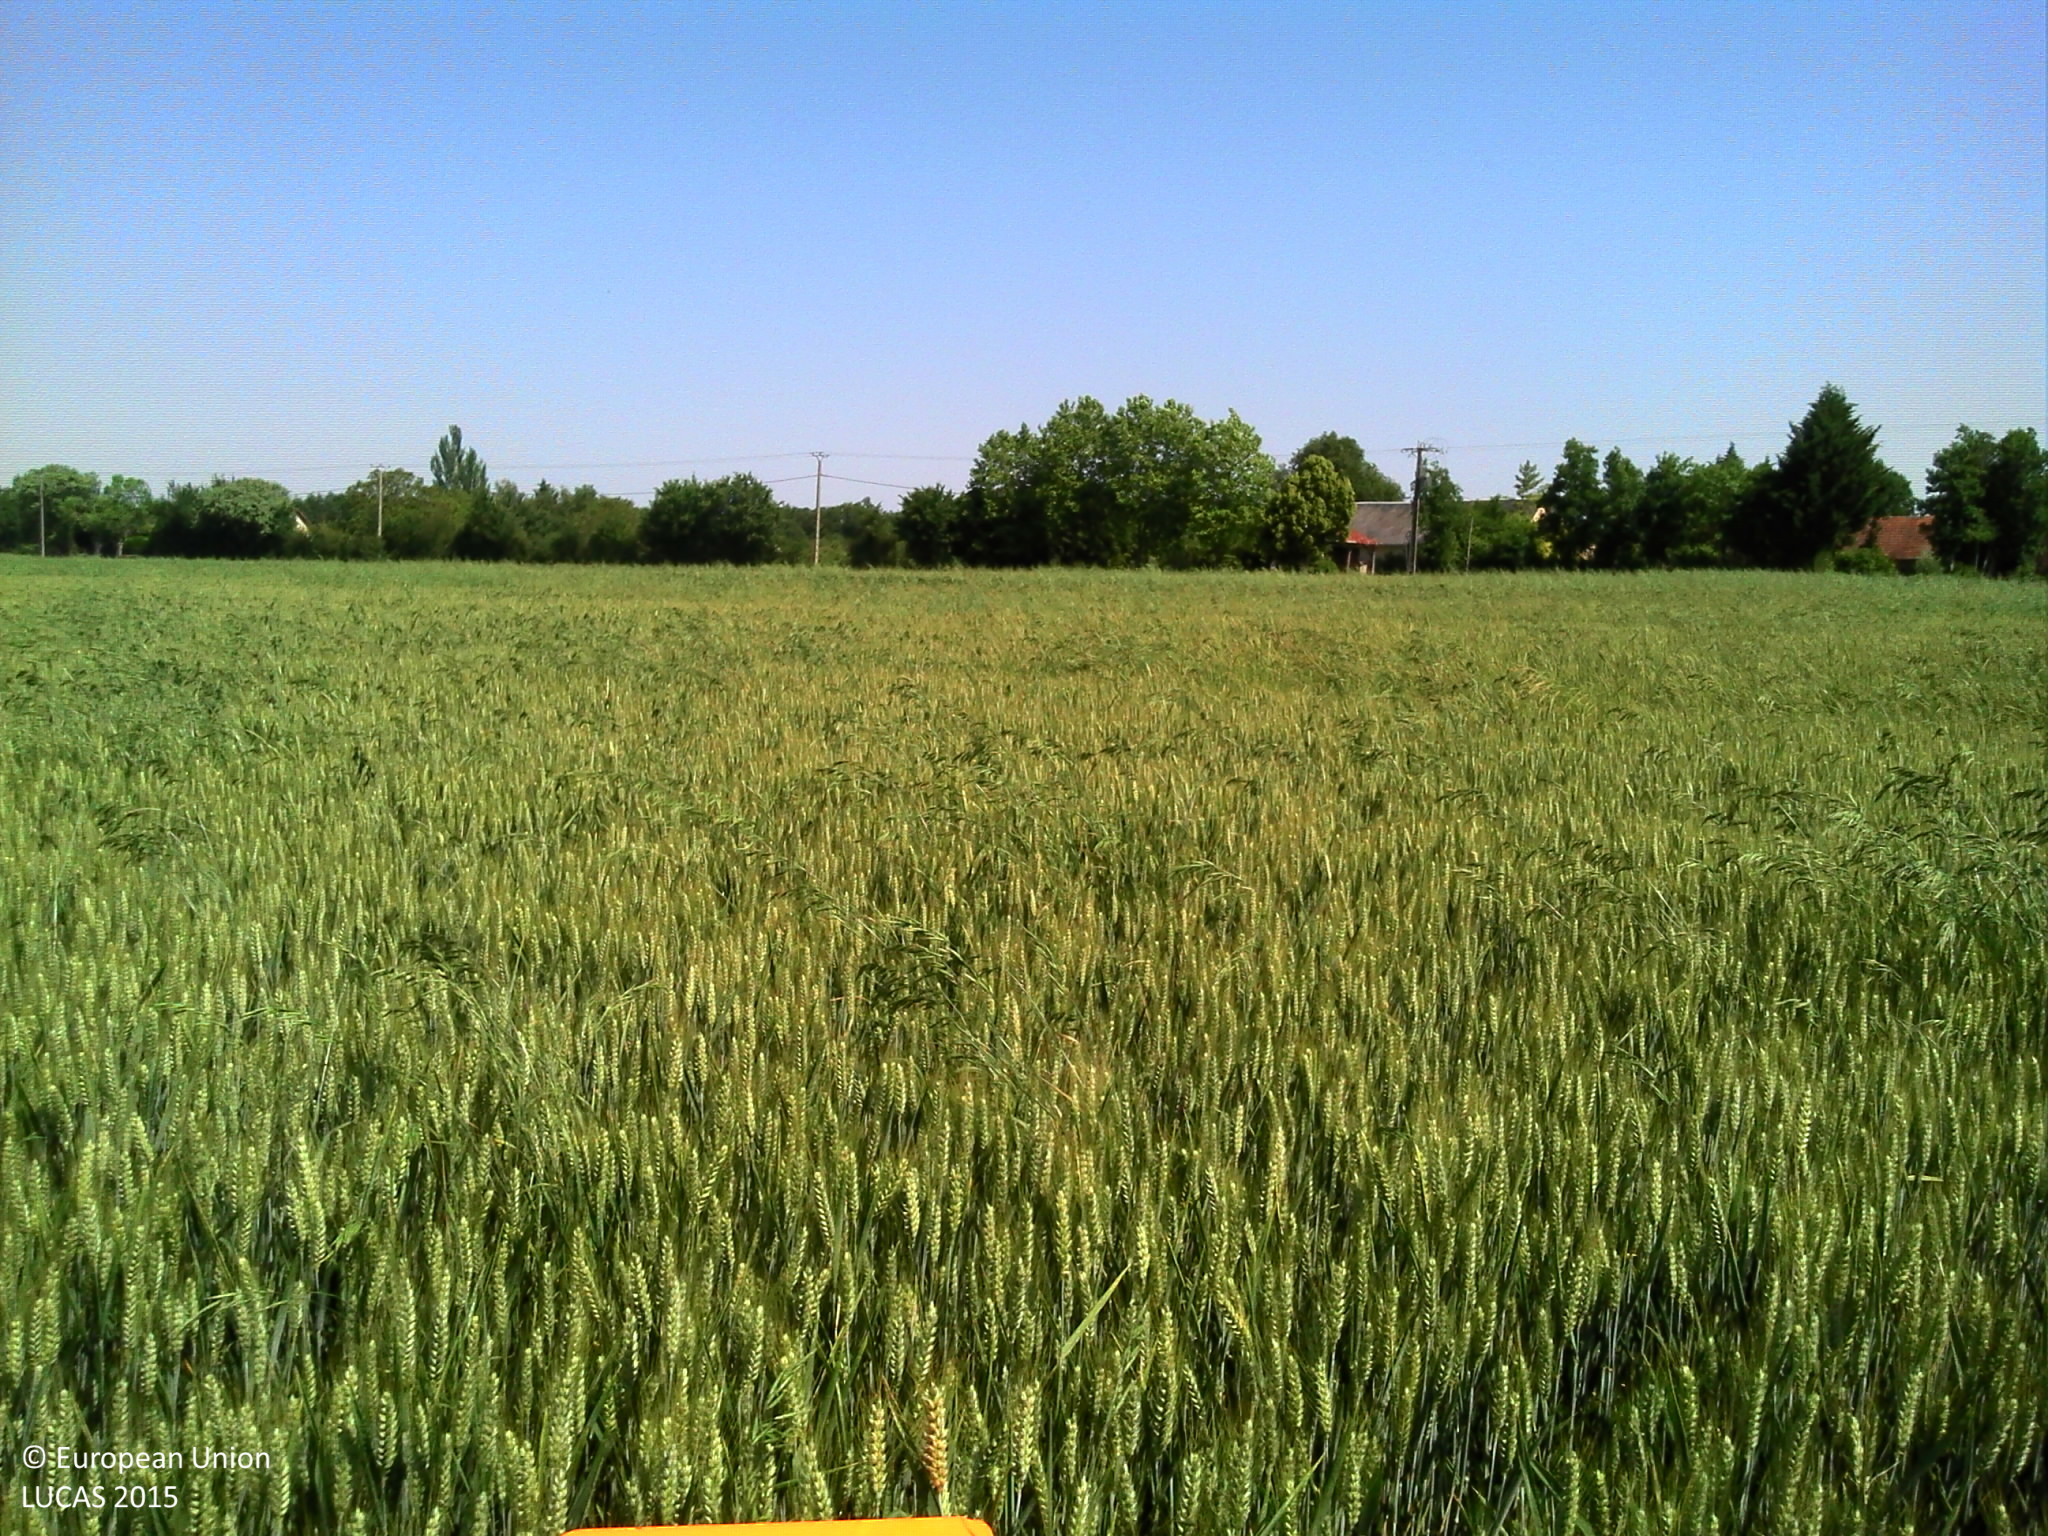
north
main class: Cropland
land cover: Common wheat
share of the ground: > 75 %
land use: Agriculture (excluding fallow land and kitchen gardens)
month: June
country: FR
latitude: 46.7742
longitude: 0.6450
